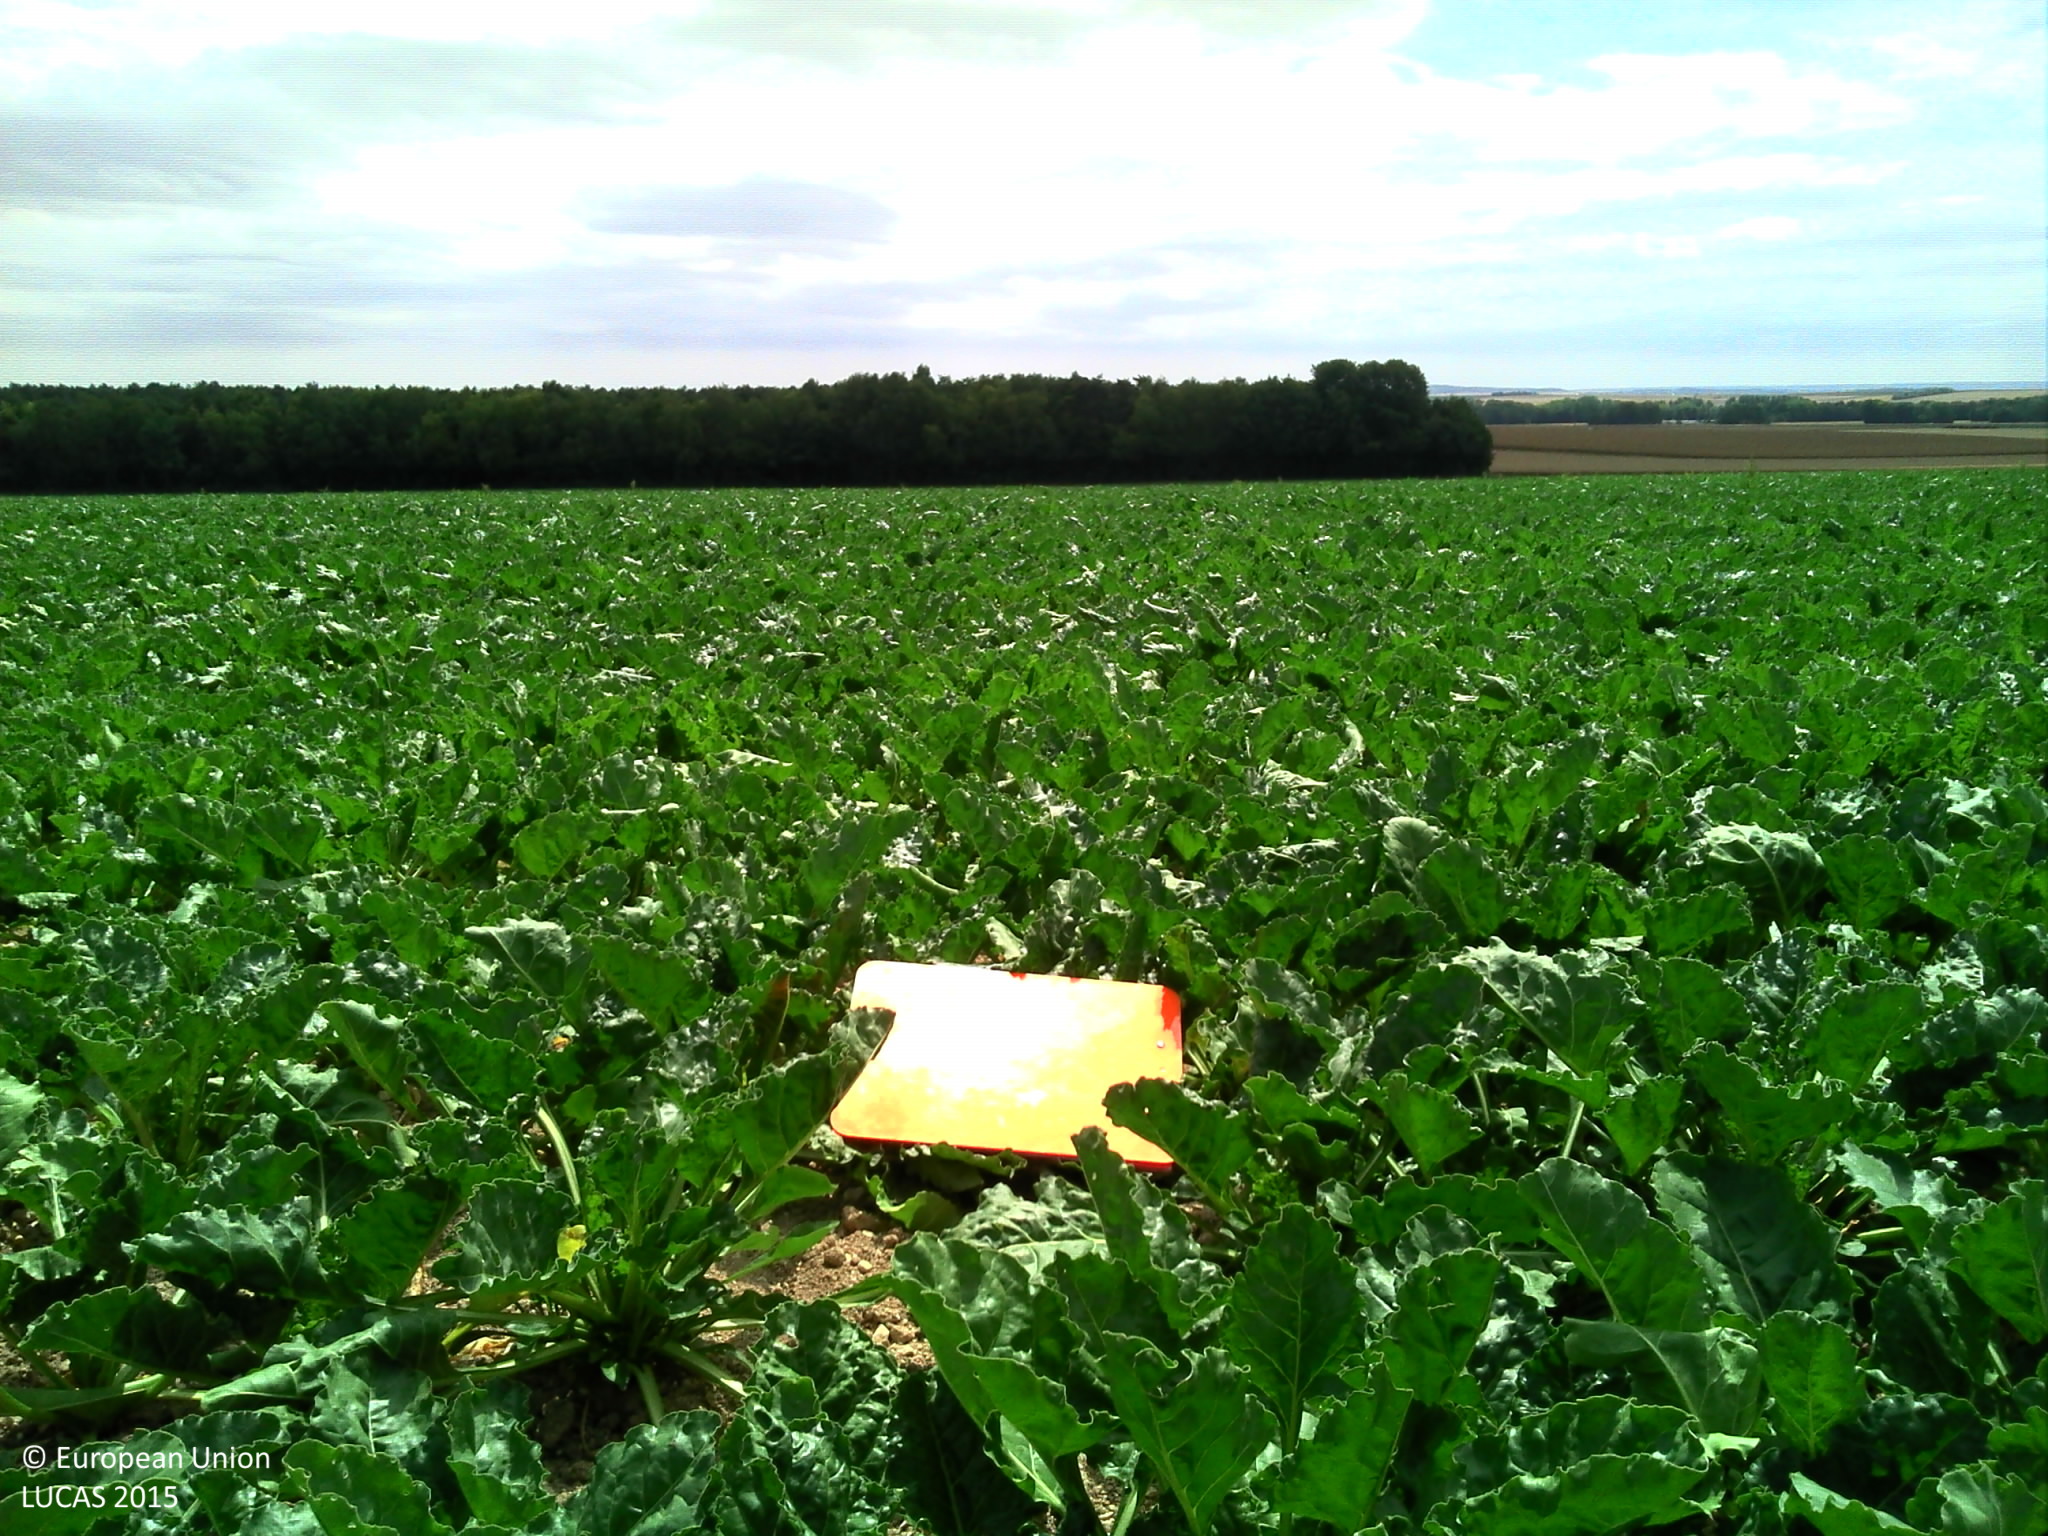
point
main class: Cropland
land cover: Sugar beet
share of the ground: > 75 %
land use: Agriculture (excluding fallow land and kitchen gardens)
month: July
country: FR
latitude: 49.4024
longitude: 4.1385
